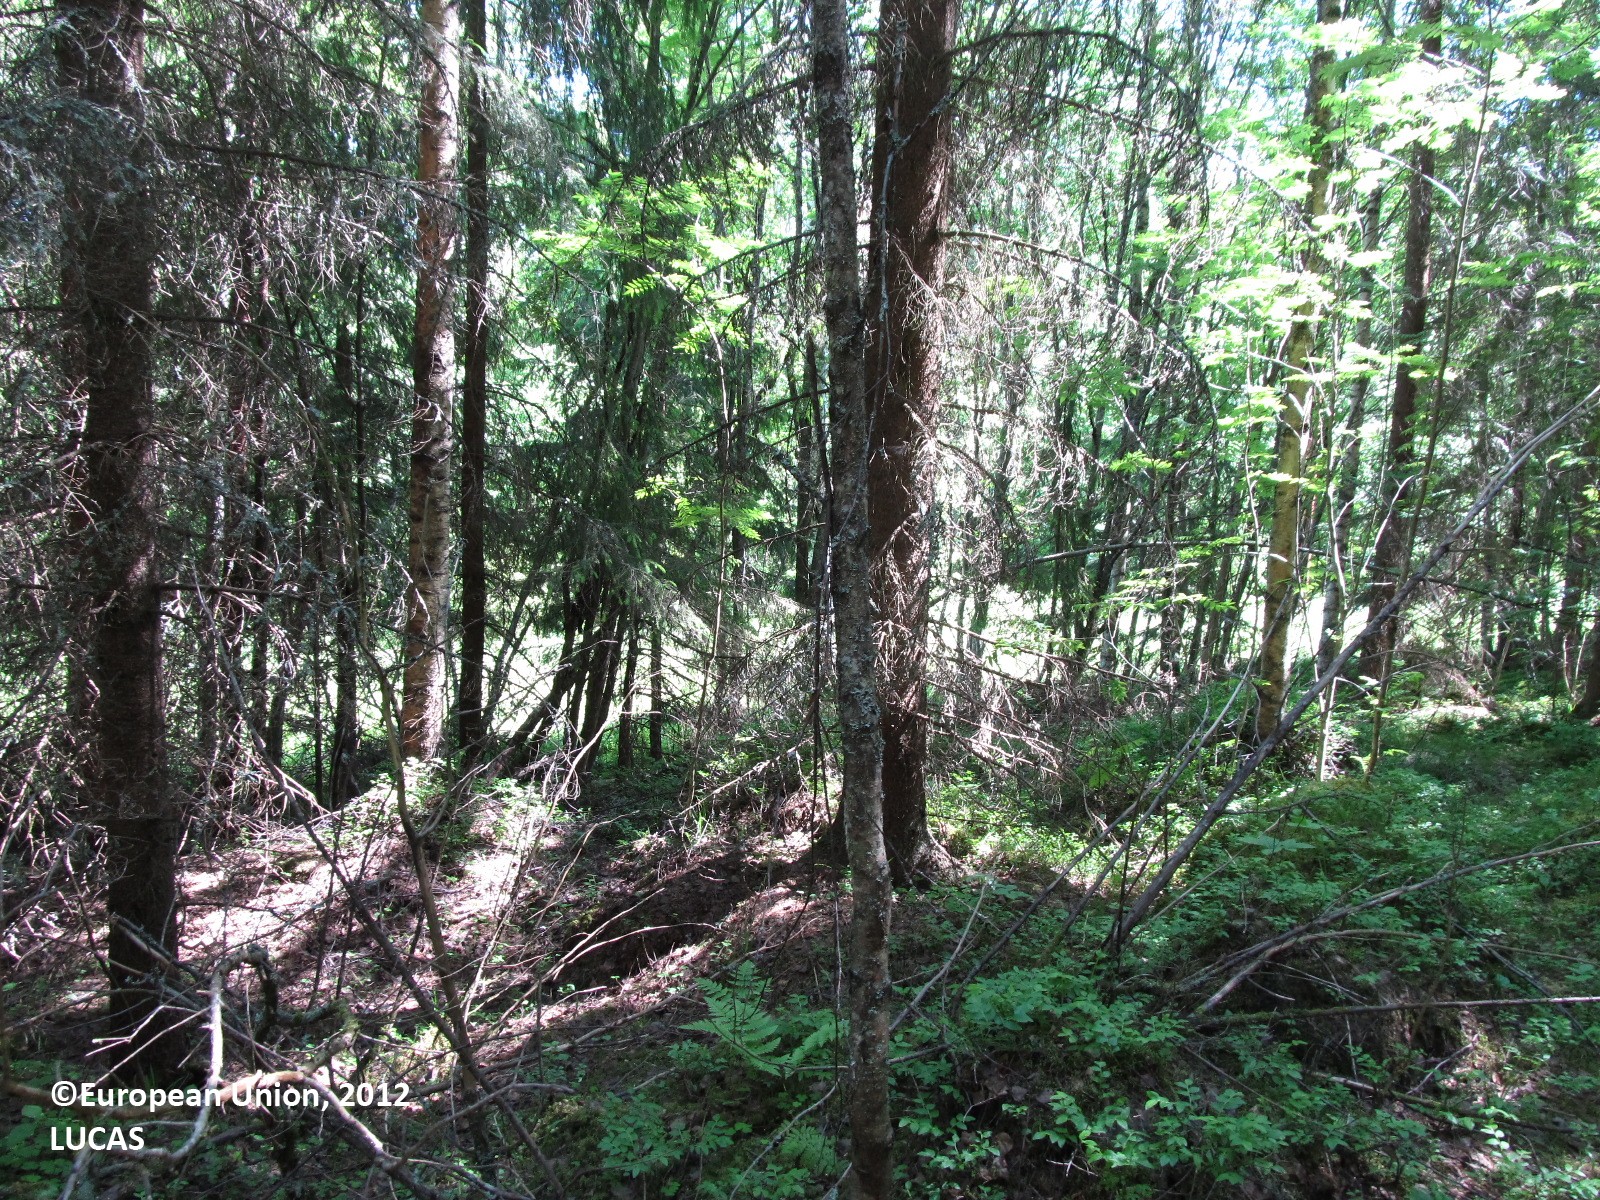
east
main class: Woodland
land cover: Spruce dominated coniferous woodland
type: boreal forest
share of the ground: 50 - 75 %
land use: Forestry
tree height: > 5 m
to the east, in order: Spruce dominated coniferous woodland; Shrubland without tree cover; Electric lines; Broadleaved woodland; Ditches and canals; Grass margins; Railways; Grass margins; Ditches and canals; Broadleaved woodland; Shrubland with sparse tree cover; Broadleaved woodland; Shrubland with sparse tree cover; Broadleaved woodland; Shrubland with sparse tree cover; Ditches and canals; Grass margins; Paved roads, cycling and walking lanes; Grass margins; Ditches and canals; Lines of trees; Temporary grasslands
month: June
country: FI
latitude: 63.0317
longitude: 27.7402
